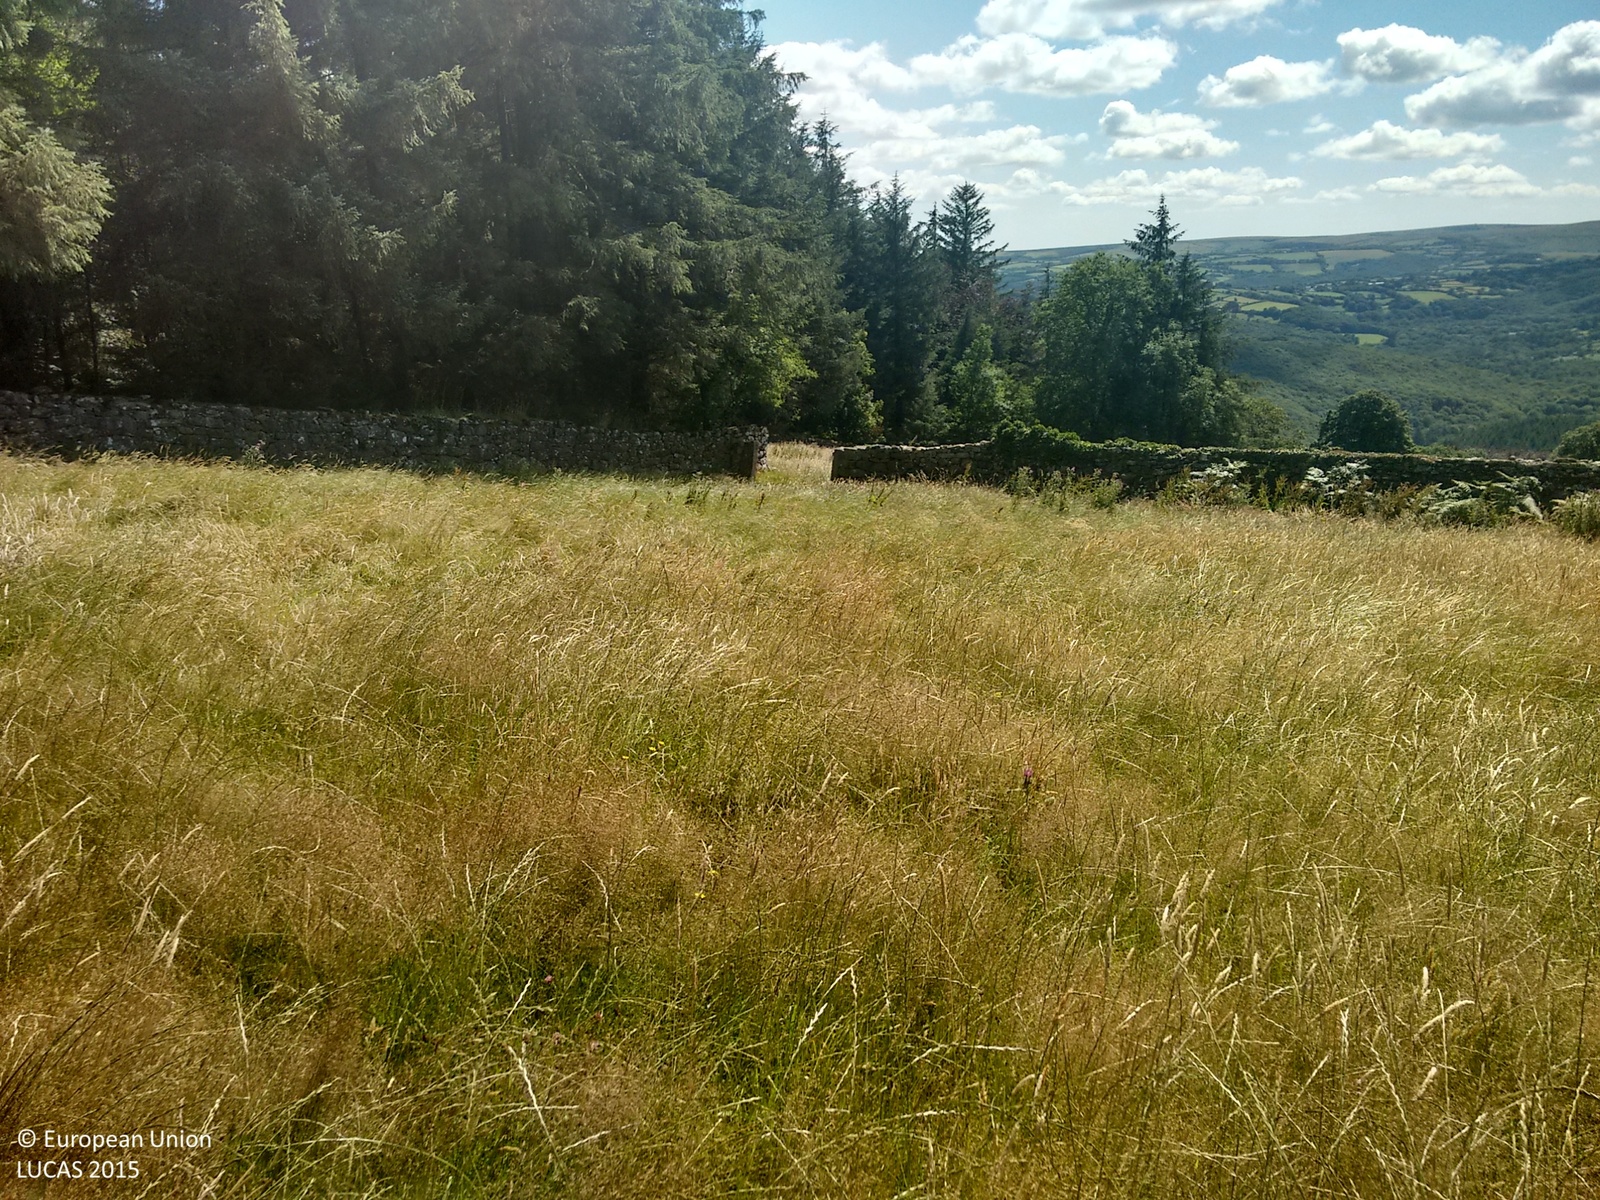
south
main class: Grassland
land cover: Grassland without tree/shrub cover
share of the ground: > 75 %
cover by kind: herbaceous plants 100 %
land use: Agriculture (excluding fallow land and kitchen gardens)
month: July
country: GB
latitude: 50.5453
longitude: -3.7921
